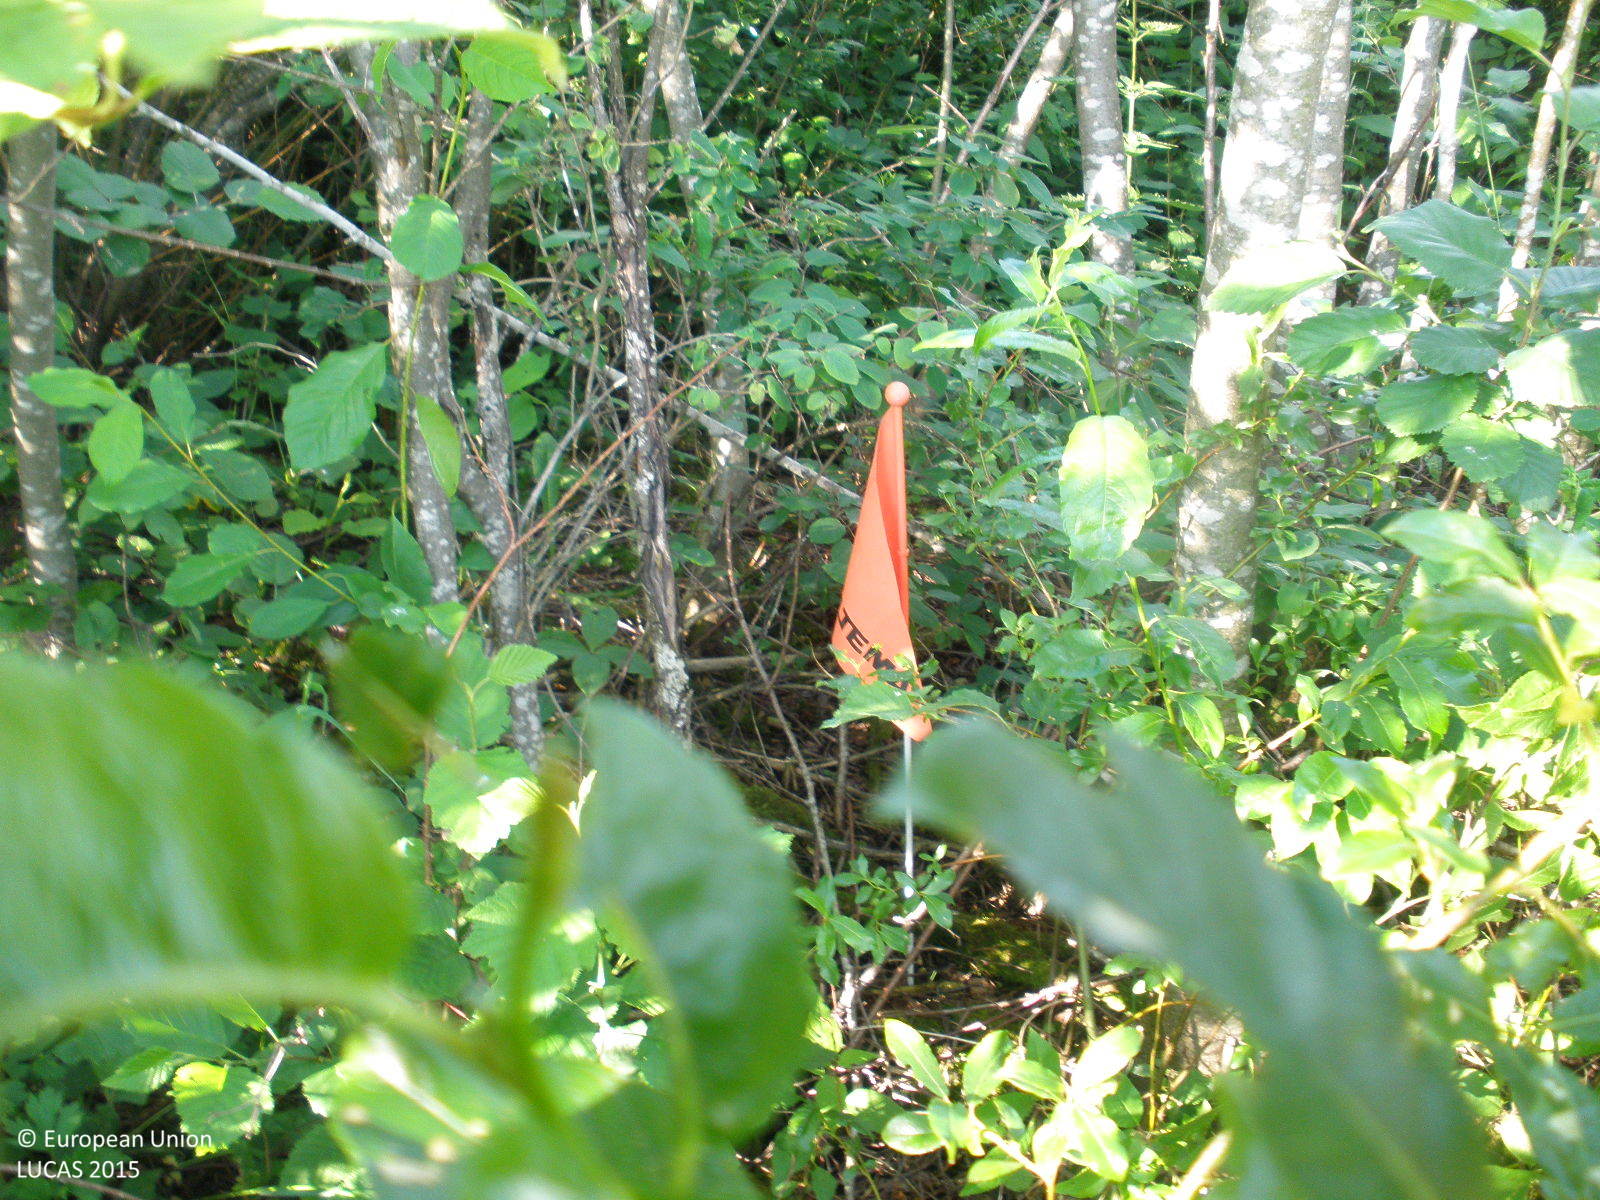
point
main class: Woodland
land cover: Broadleaved woodland
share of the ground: > 75 %
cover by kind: broadleaved forest trees 90 %, herbaceous plants 10 %
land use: Forestry
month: July
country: FI
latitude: 61.3520
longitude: 24.5163
